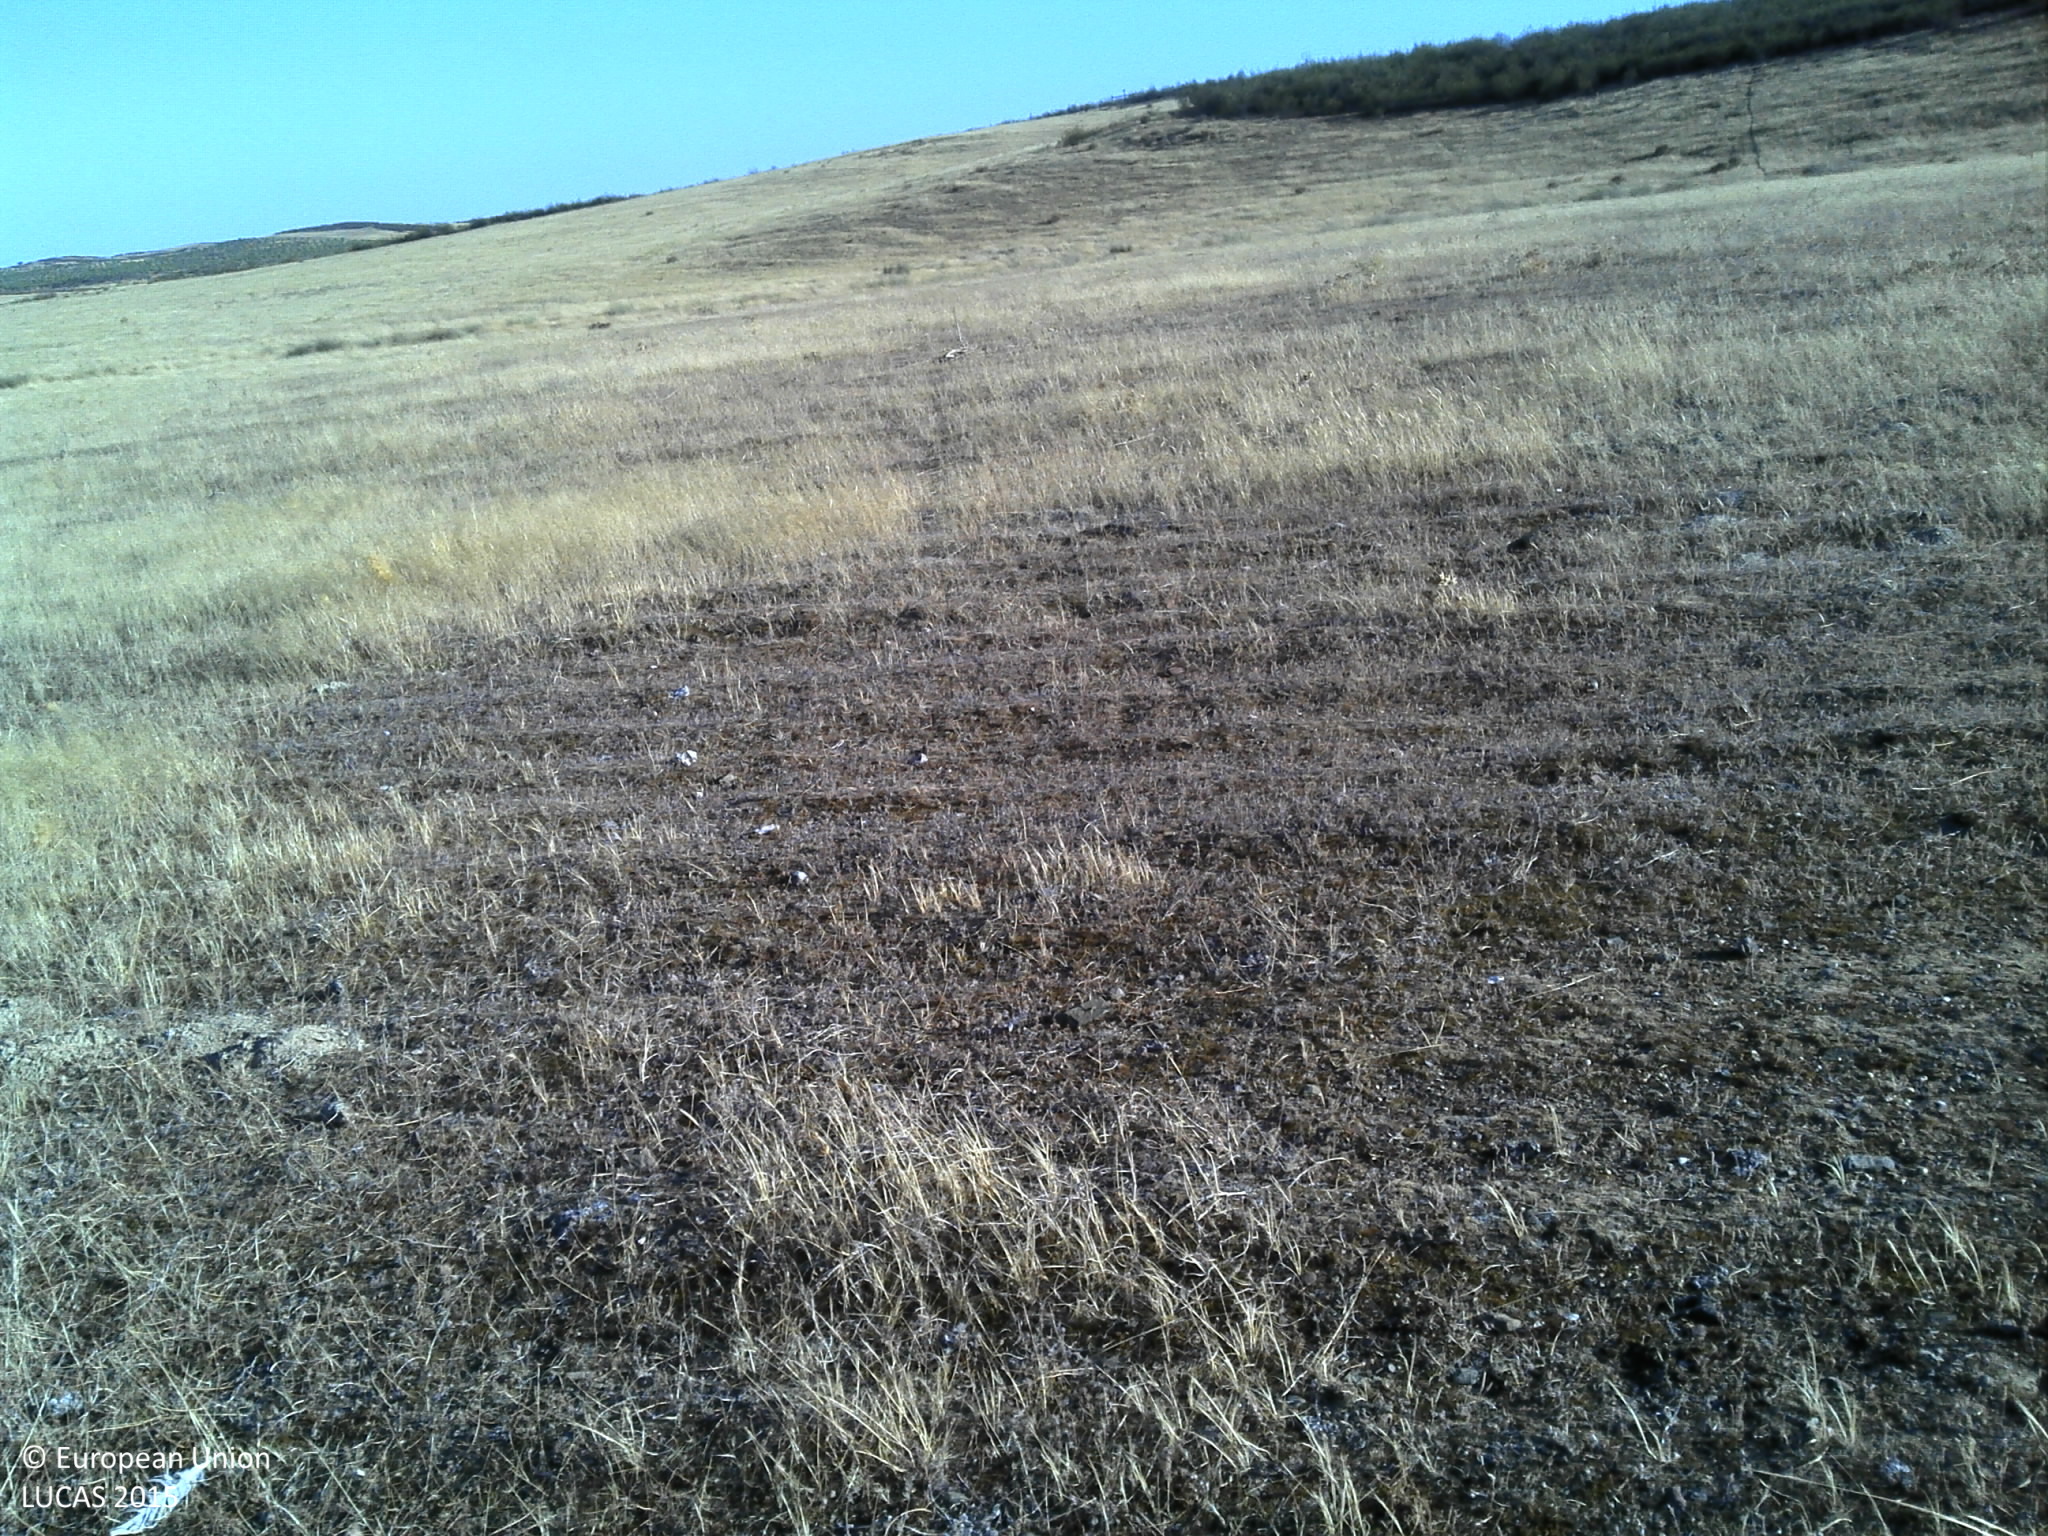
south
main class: Grassland
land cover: Grassland without tree/shrub cover
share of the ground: < 10 %
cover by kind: unconsolidated bare surface 90 %, herbaceous plants 10 %
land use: Agriculture (excluding fallow land and kitchen gardens)
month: July
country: PT
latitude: 37.6632
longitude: -7.8987
